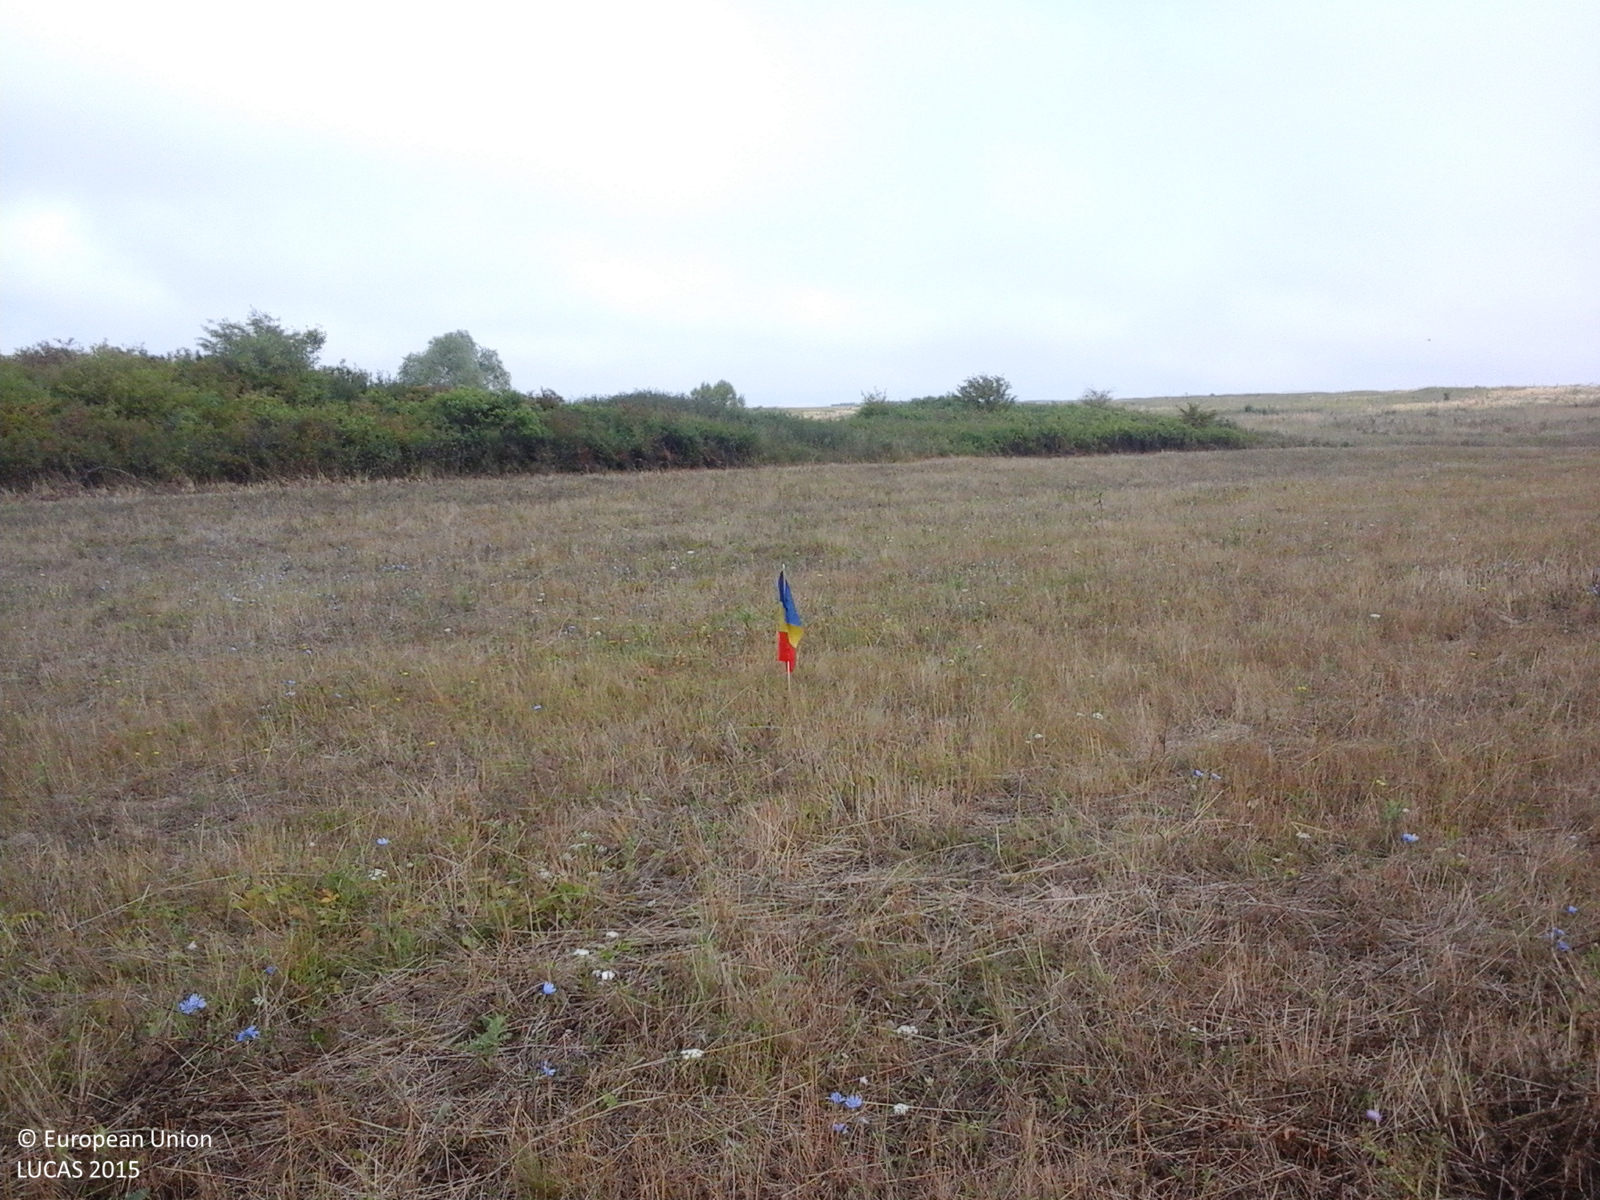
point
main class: Grassland
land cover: Grassland without tree/shrub cover
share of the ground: > 75 %
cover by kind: herbaceous plants 100 %
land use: Agriculture (excluding fallow land and kitchen gardens)
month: August
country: RO
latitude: 44.9822
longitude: 21.5063
